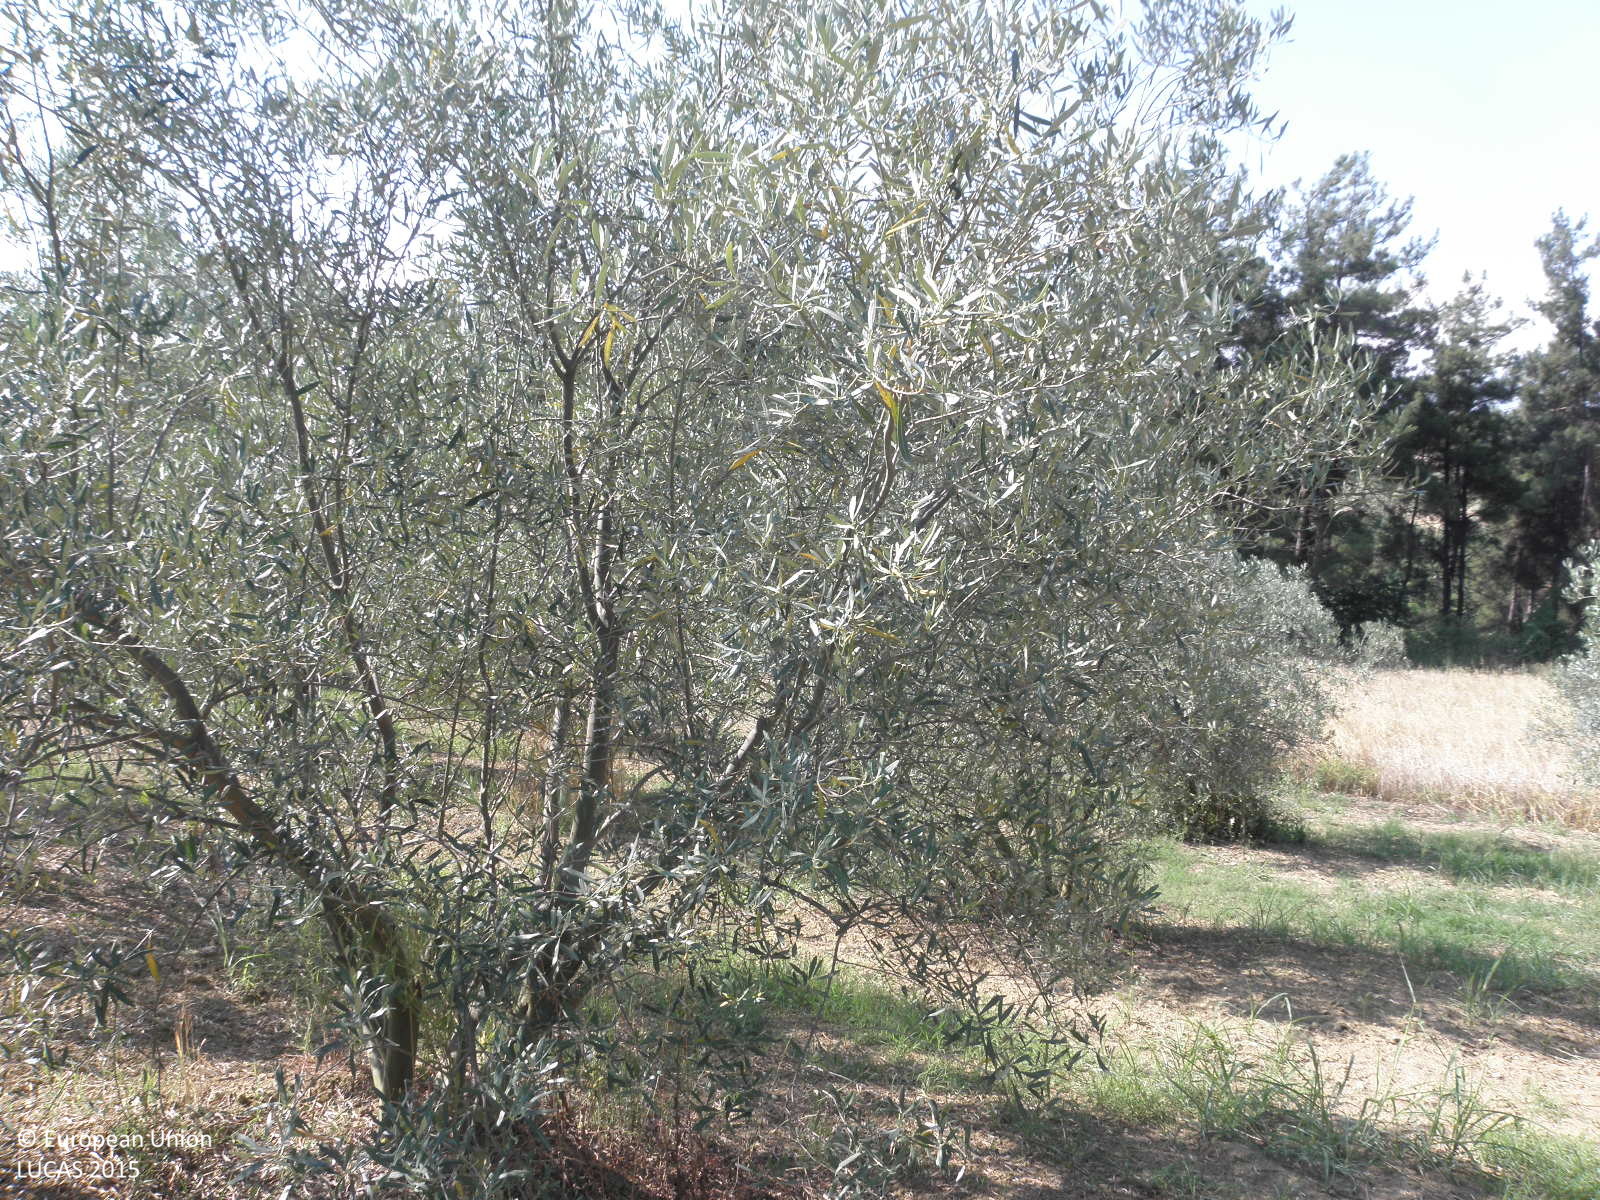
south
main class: Cropland
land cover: Olive groves
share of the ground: 25 - 50 %
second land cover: Grassland without tree/shrub cover
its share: 50 - 75 %
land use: Agriculture (excluding fallow land and kitchen gardens)
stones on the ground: < 10 %
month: June
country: GR
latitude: 40.3939
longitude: 22.5232
